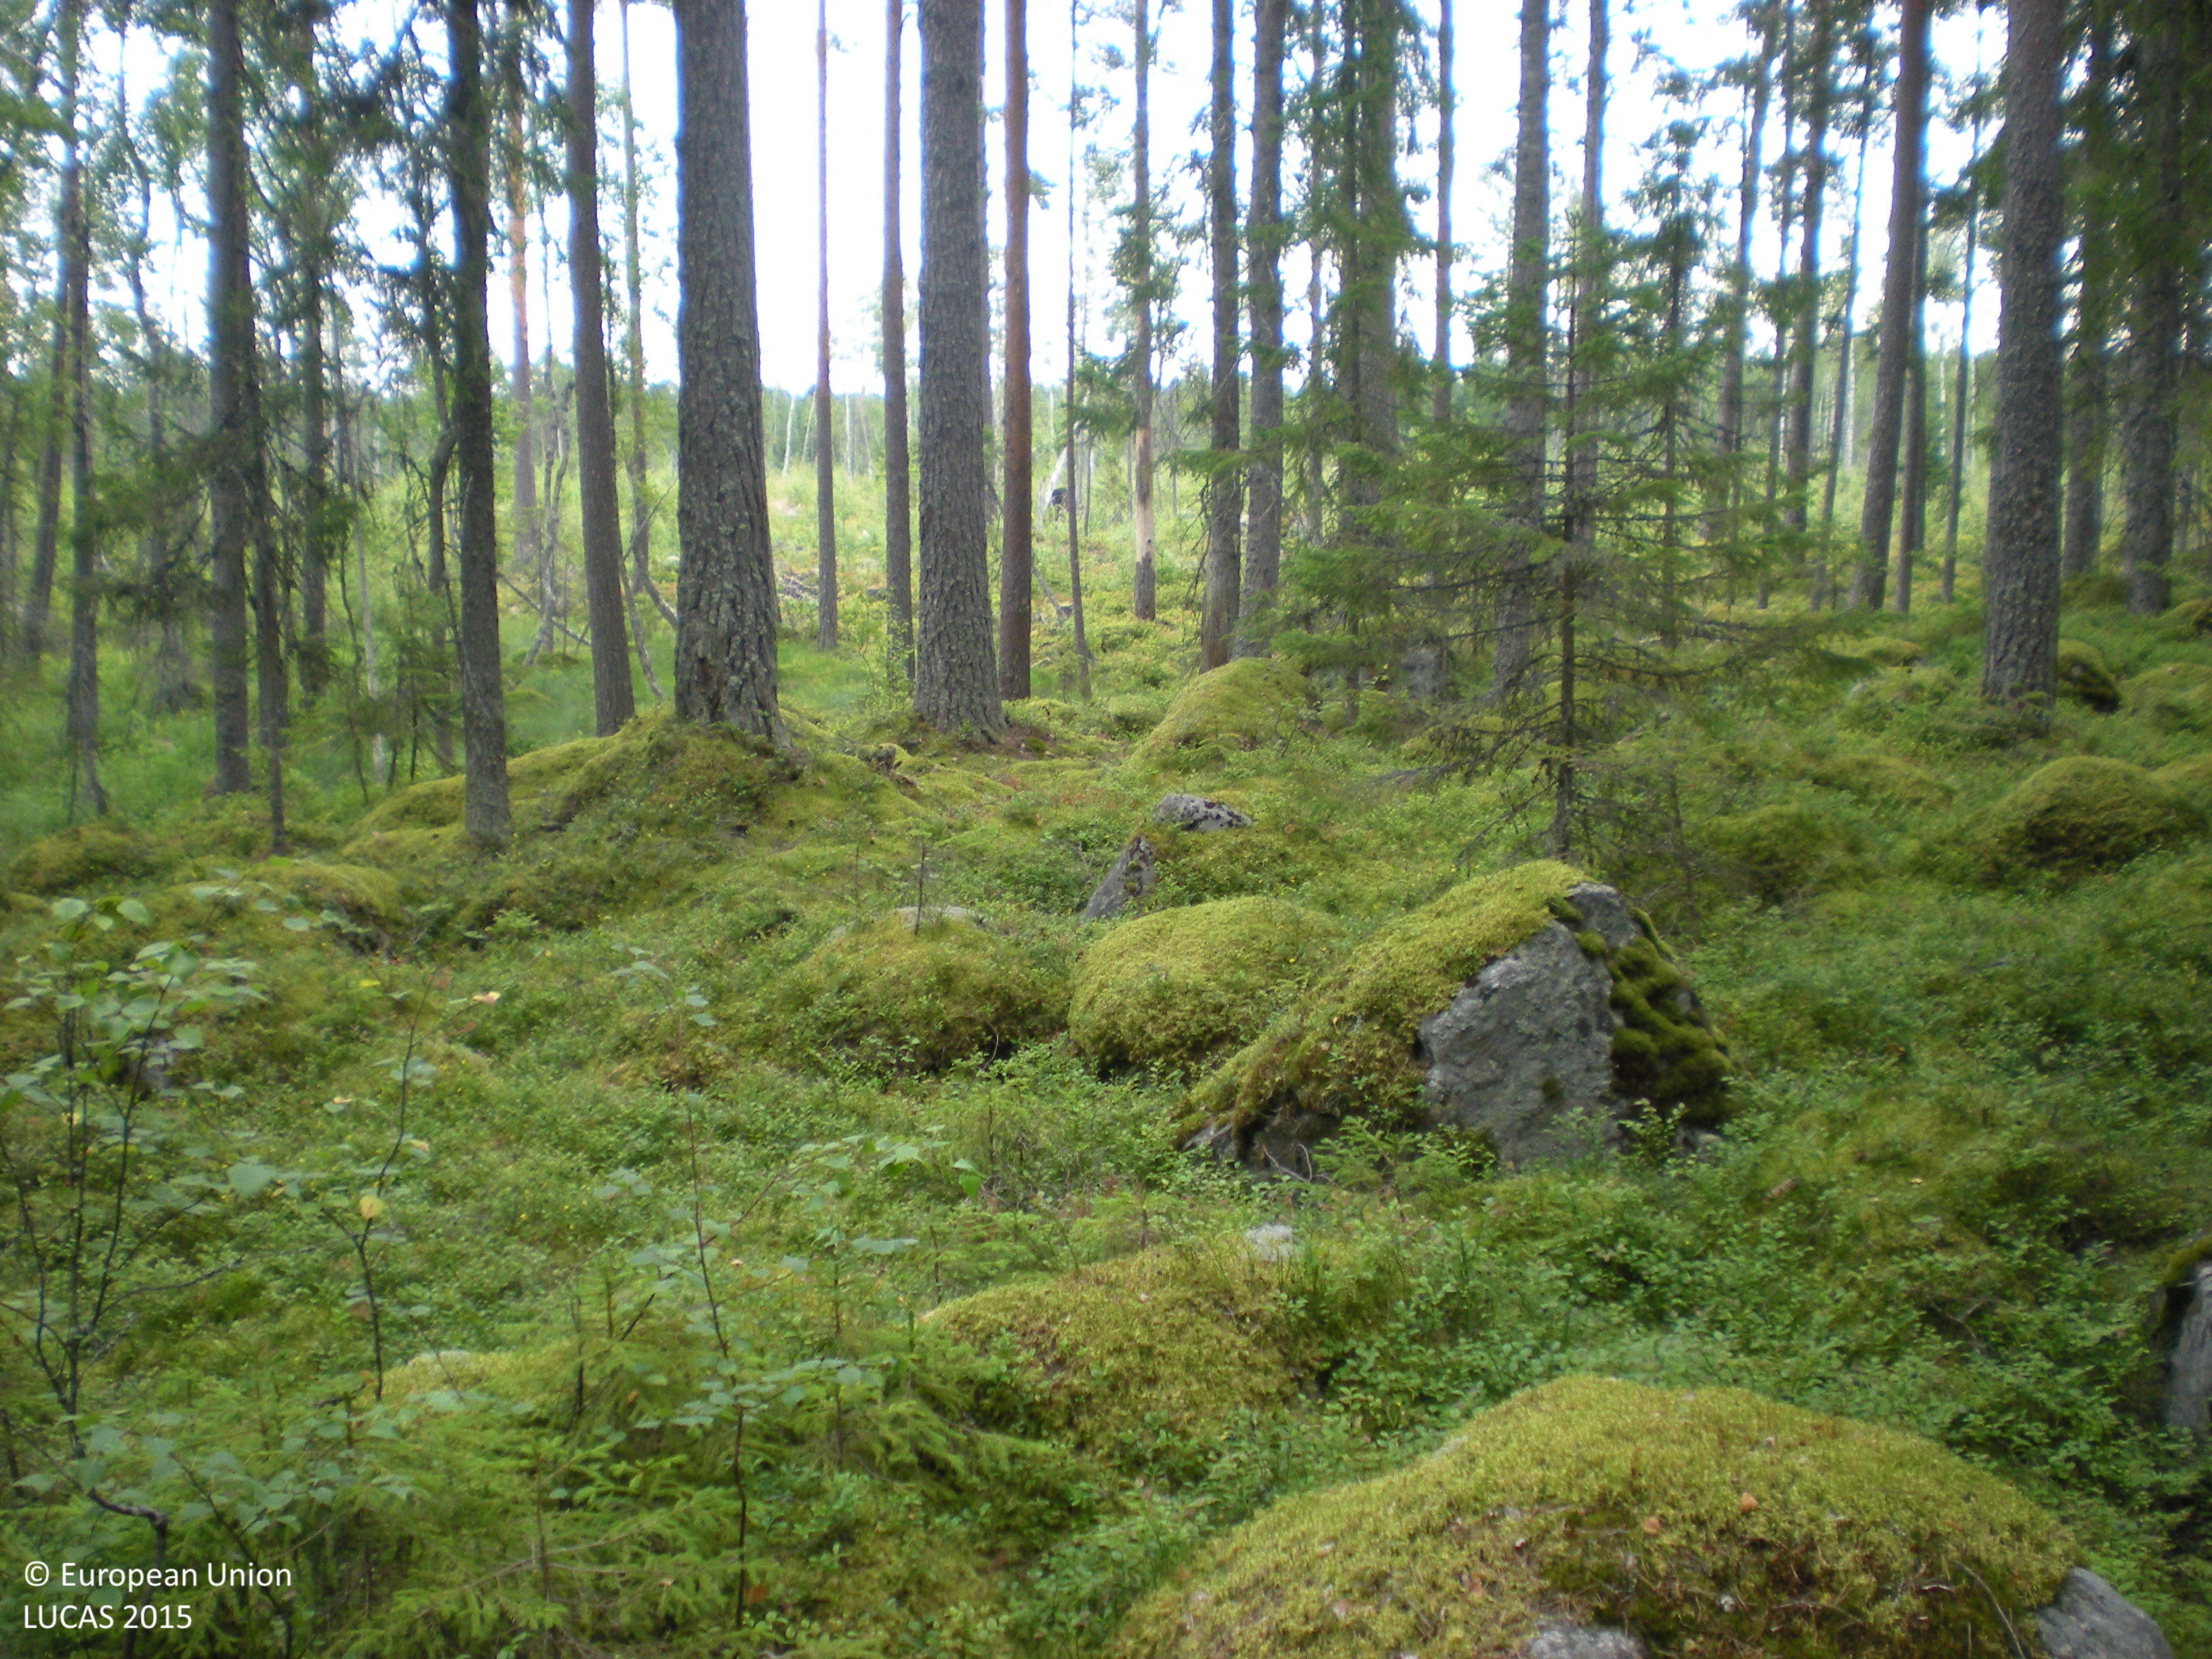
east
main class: Woodland
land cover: Other coniferous woodland
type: boreal forest
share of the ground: 50 - 75 %
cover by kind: coniferous forest trees 65 %, shrubs 15 %, lichens and mosses 10 %, herbaceous plants 5 %, consolidated bare surface 5 %
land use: Forestry
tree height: > 5 m
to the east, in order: Other coniferous woodland; Pine dominated mixed woodland; Broadleaved woodland; Other mixed woodland; Pine dominated coniferous woodland
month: August
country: SE
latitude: 60.8477
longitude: 17.1838
